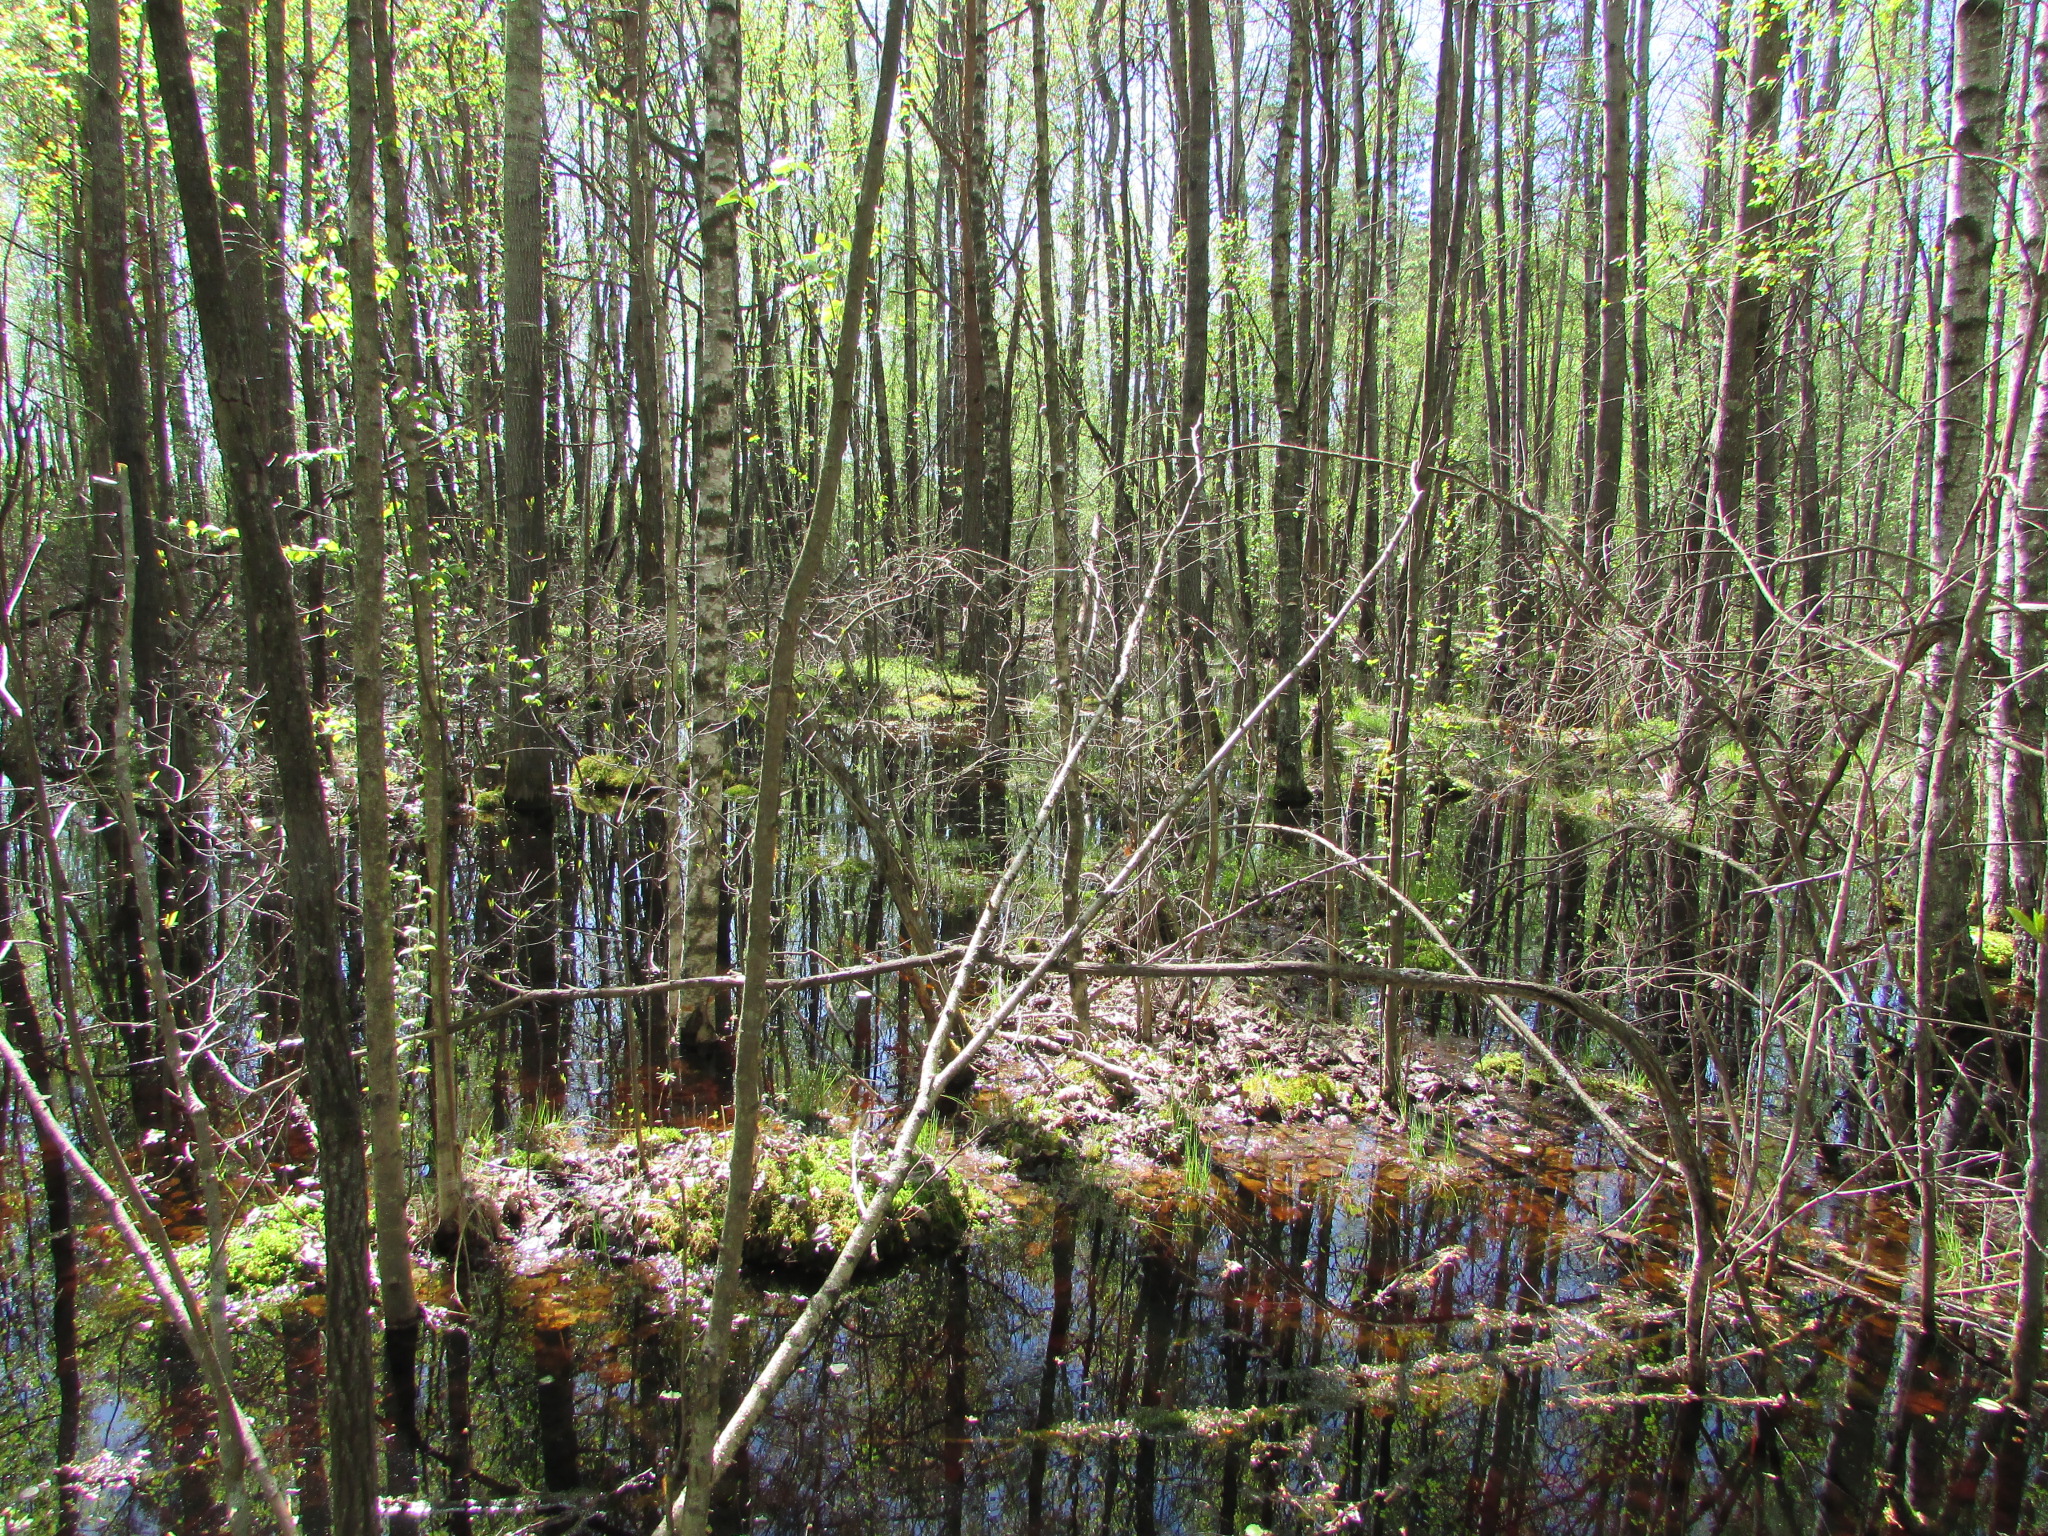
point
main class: Woodland
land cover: Broadleaved woodland
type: floodplain forest
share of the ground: > 75 %
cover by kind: broadleaved forest trees 100 %
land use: Forestry
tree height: > 5 m
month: May
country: LV
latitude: 56.0486
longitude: 27.0402
